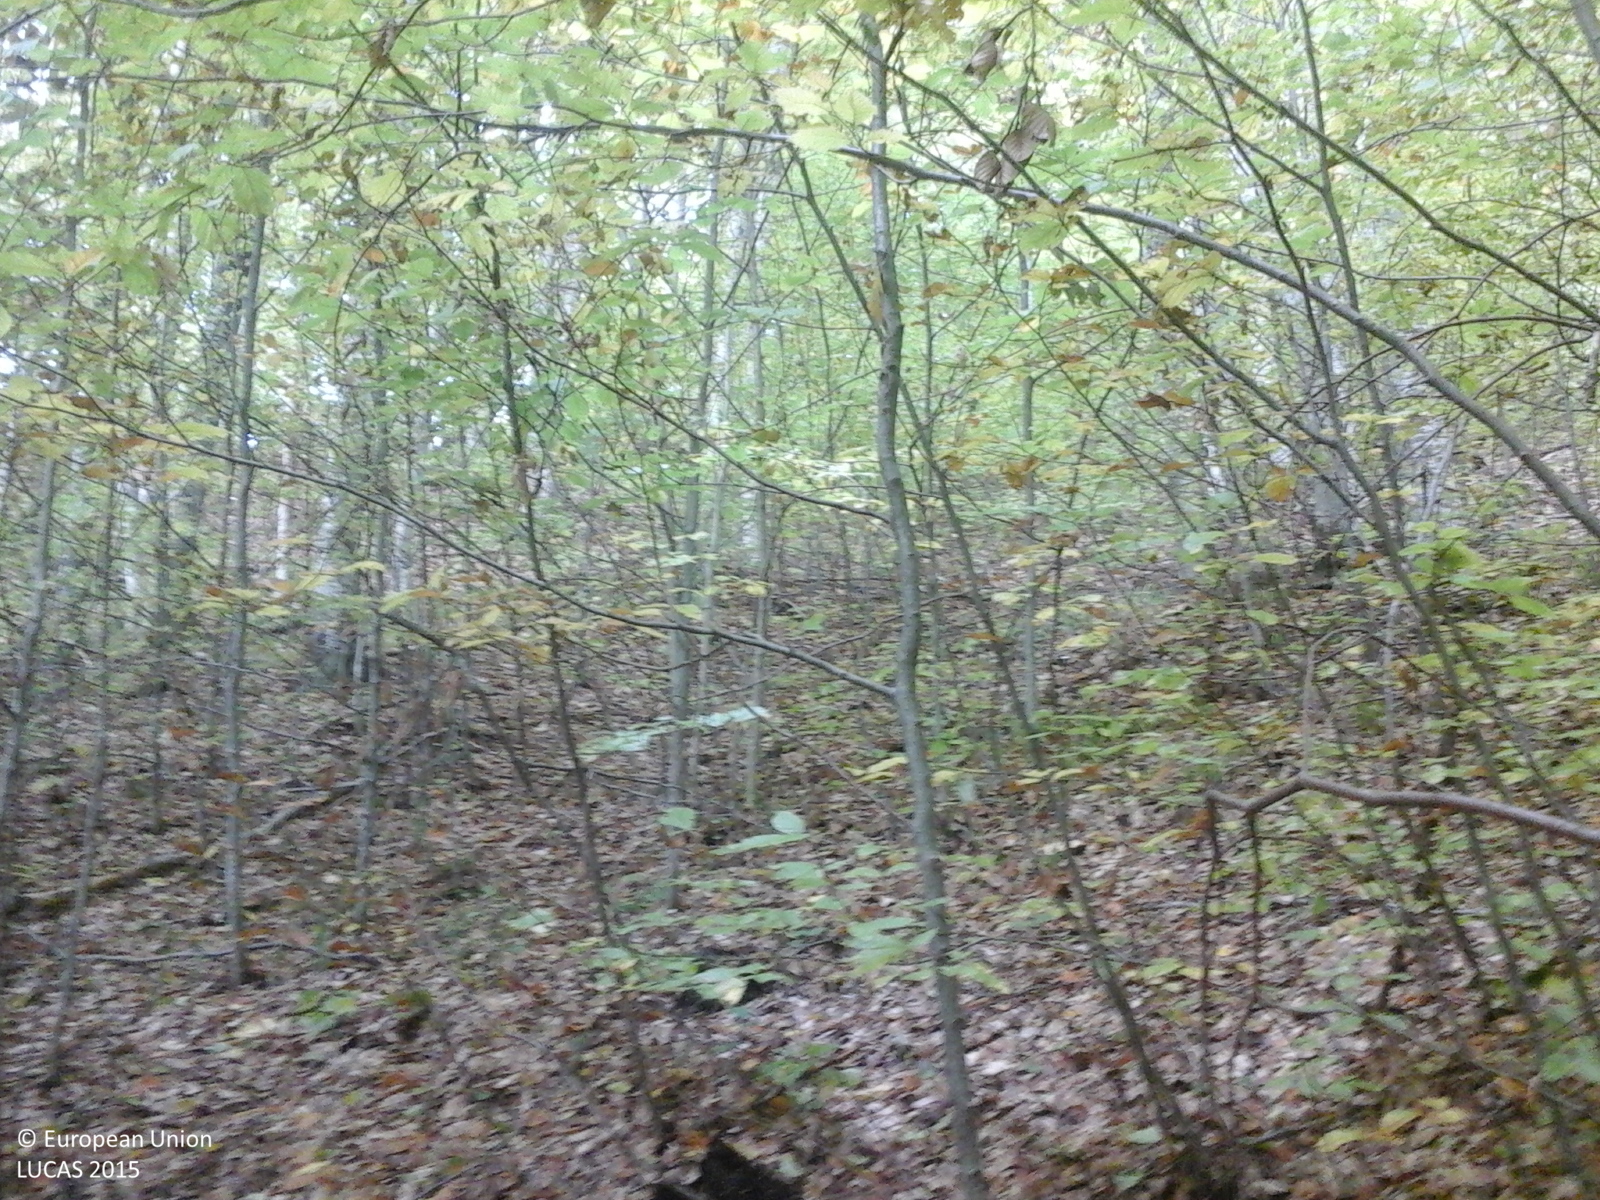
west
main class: Woodland
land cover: Broadleaved woodland
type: beech forest
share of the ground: > 75 %
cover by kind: broadleaved forest trees 100 %
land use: Forestry
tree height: > 5 m
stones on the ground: 10 - 25 %
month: October
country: RO
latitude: 46.5859
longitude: 25.2558
